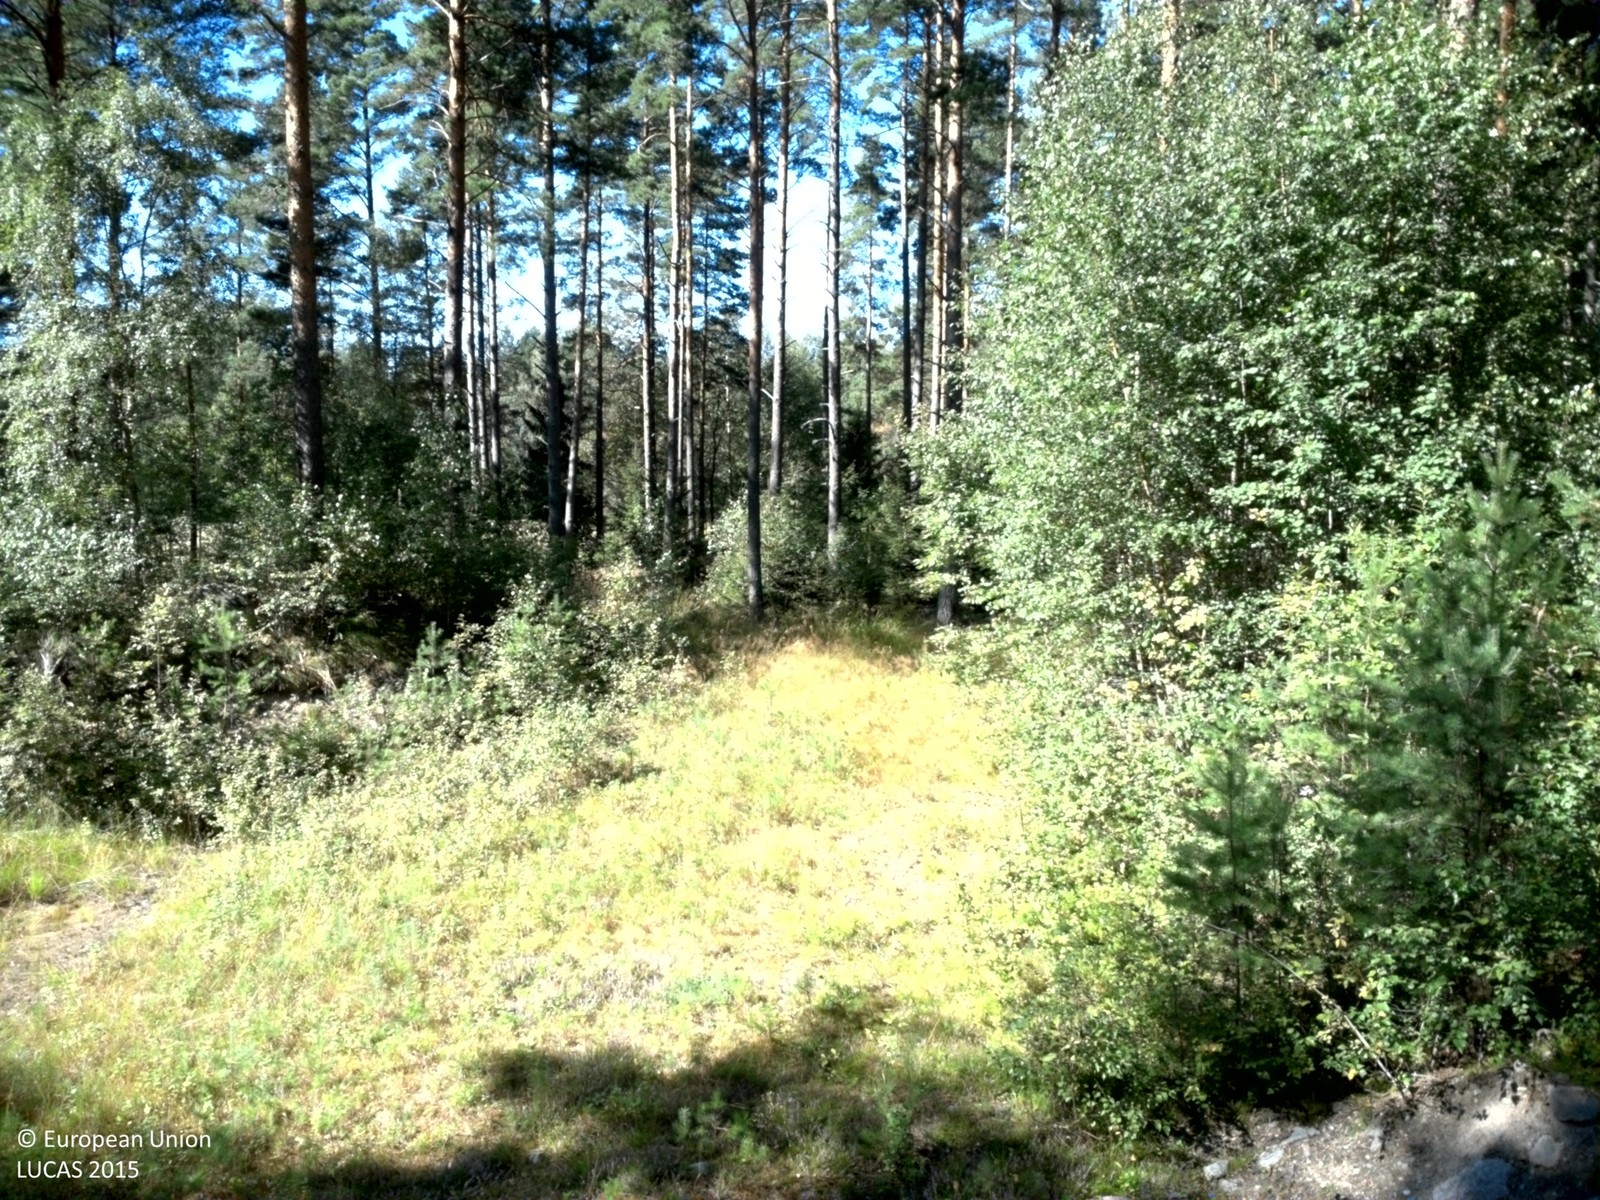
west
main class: Woodland
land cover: Pine dominated coniferous woodland
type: boreal forest
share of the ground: 50 - 75 %
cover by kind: coniferous forest trees 50 %, shrubs 20 %, lichens and mosses 20 %, broadleaved forest trees 5 %, herbaceous plants 5 %
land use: Forestry
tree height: > 5 m
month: August
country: SE
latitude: 59.7810
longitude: 16.8143
